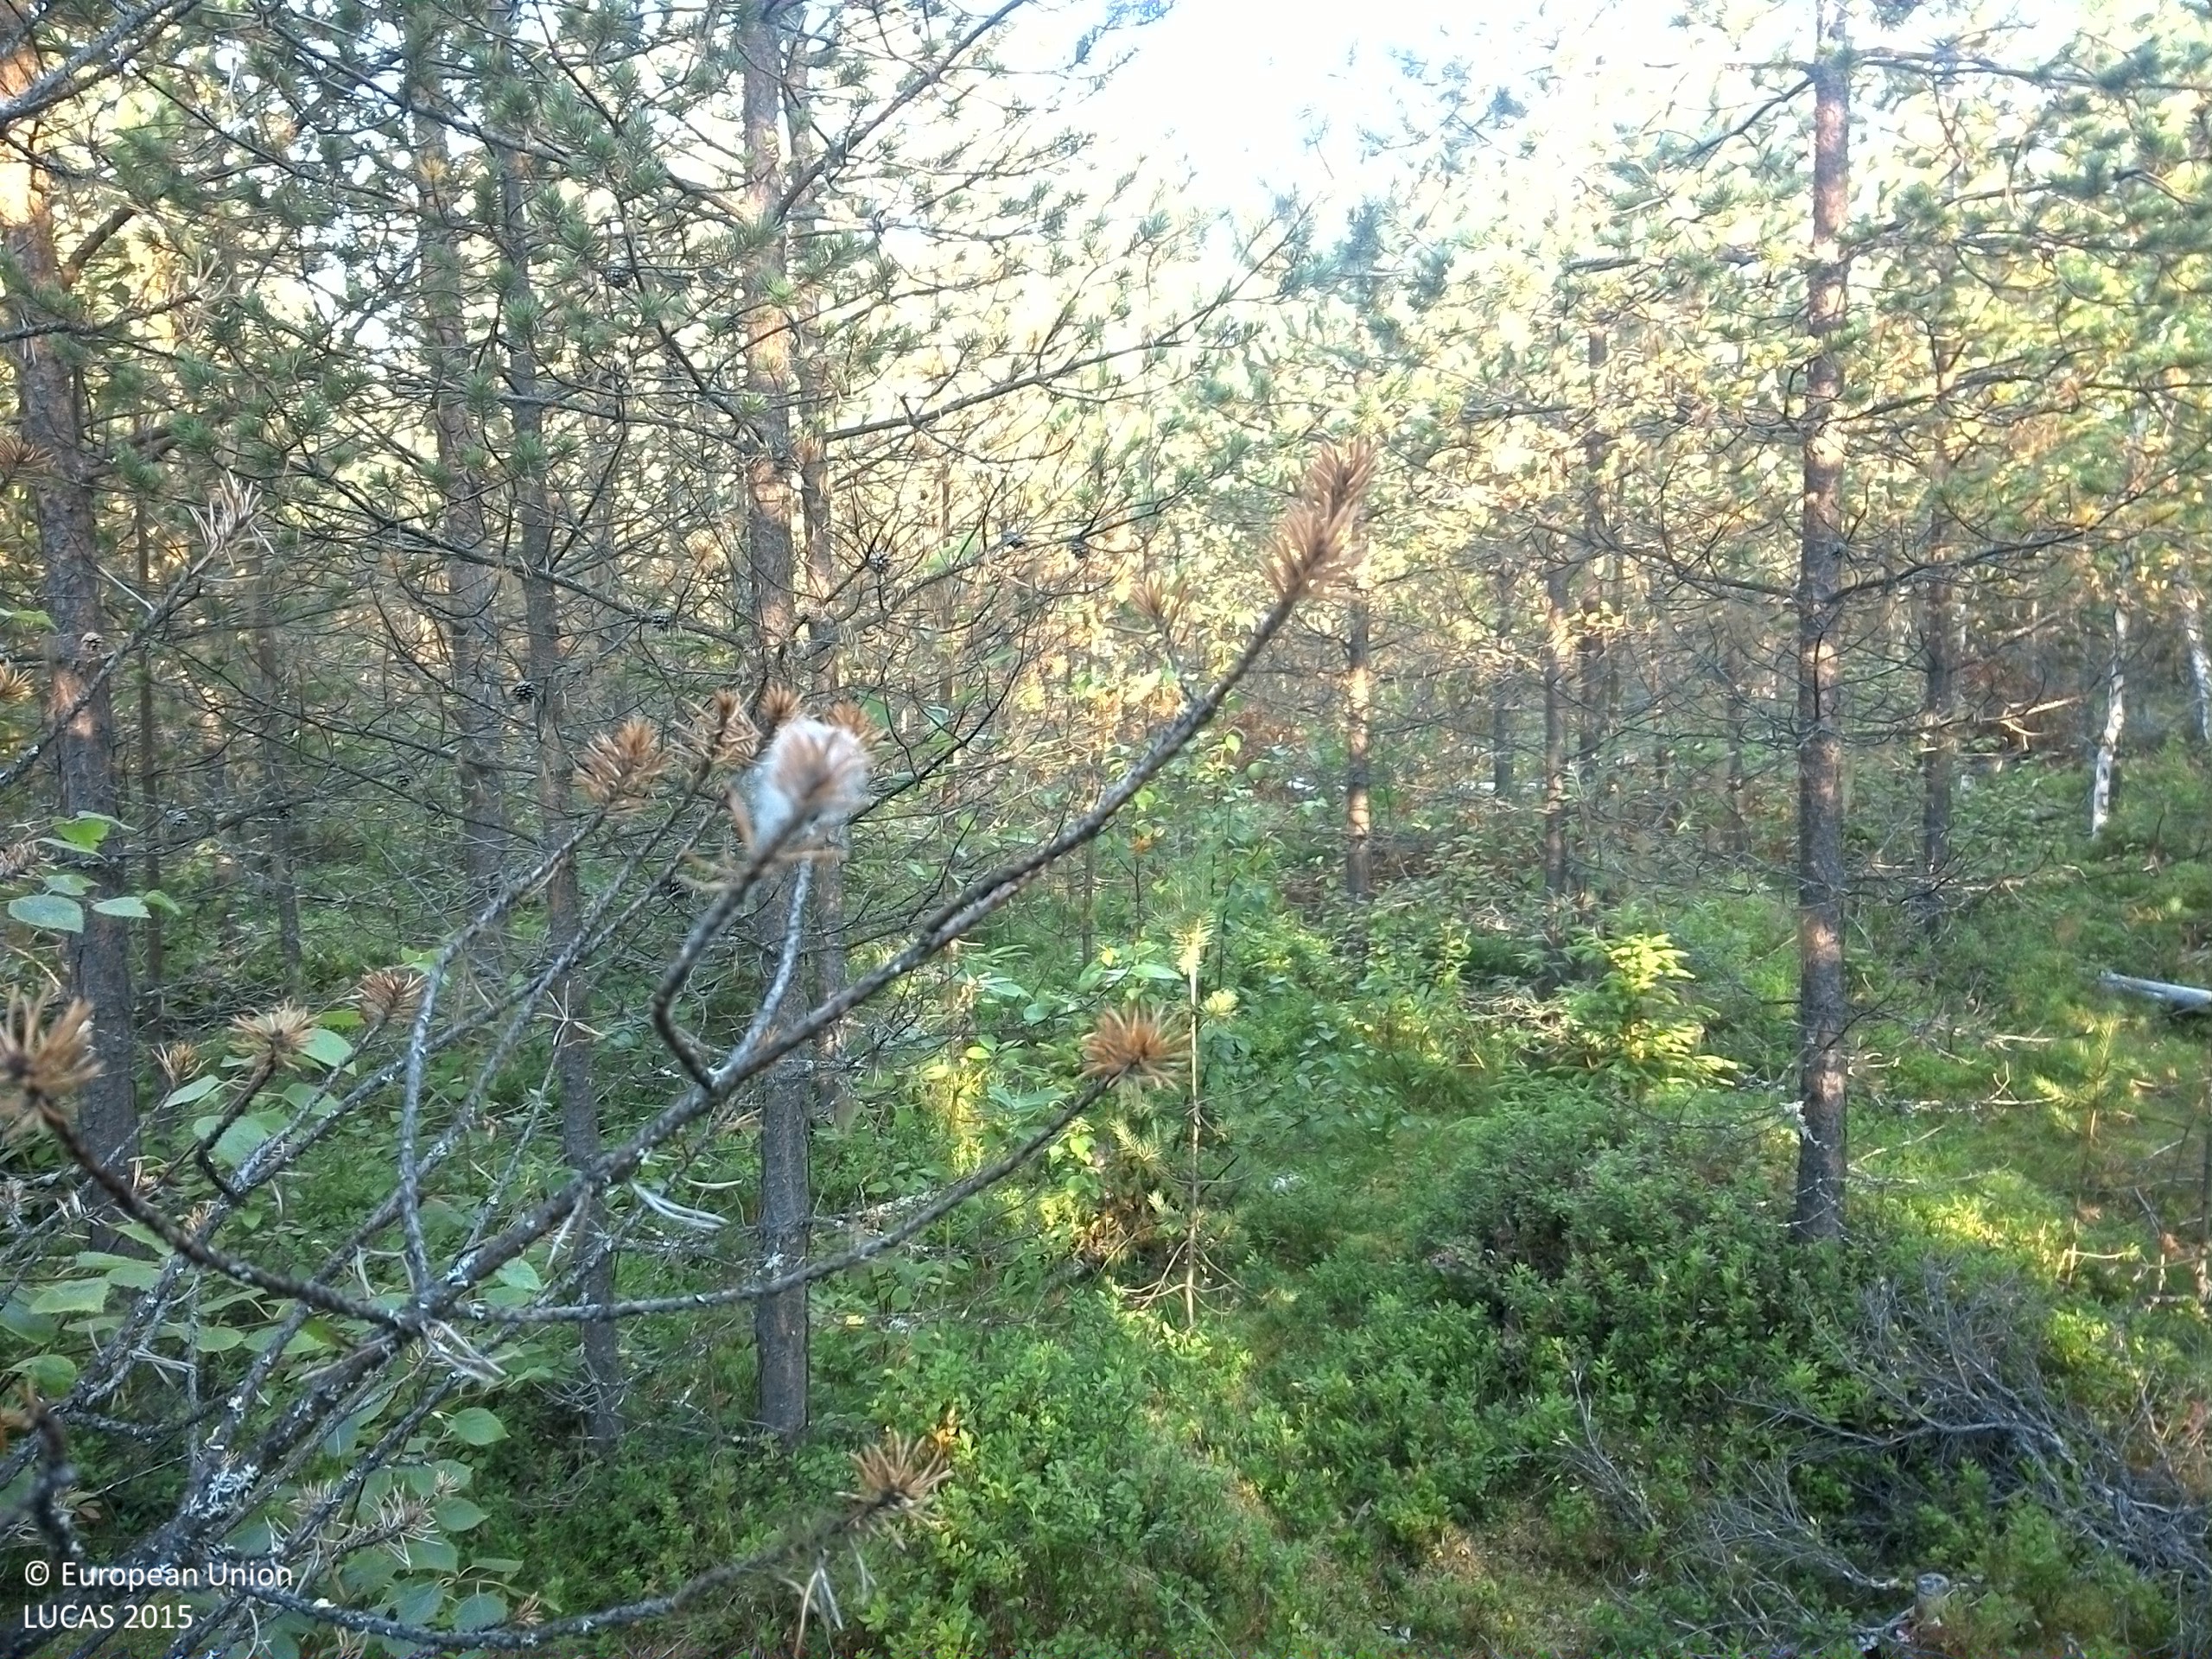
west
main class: Woodland
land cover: Pine dominated coniferous woodland
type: boreal forest
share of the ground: 25 - 50 %
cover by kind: shrubs 40 %, coniferous forest trees 35 %, lichens and mosses 15 %, broadleaved forest trees 5 %, herbaceous plants 5 %
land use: Forestry
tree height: > 5 m
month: August
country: SE
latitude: 64.1141
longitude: 16.6422
